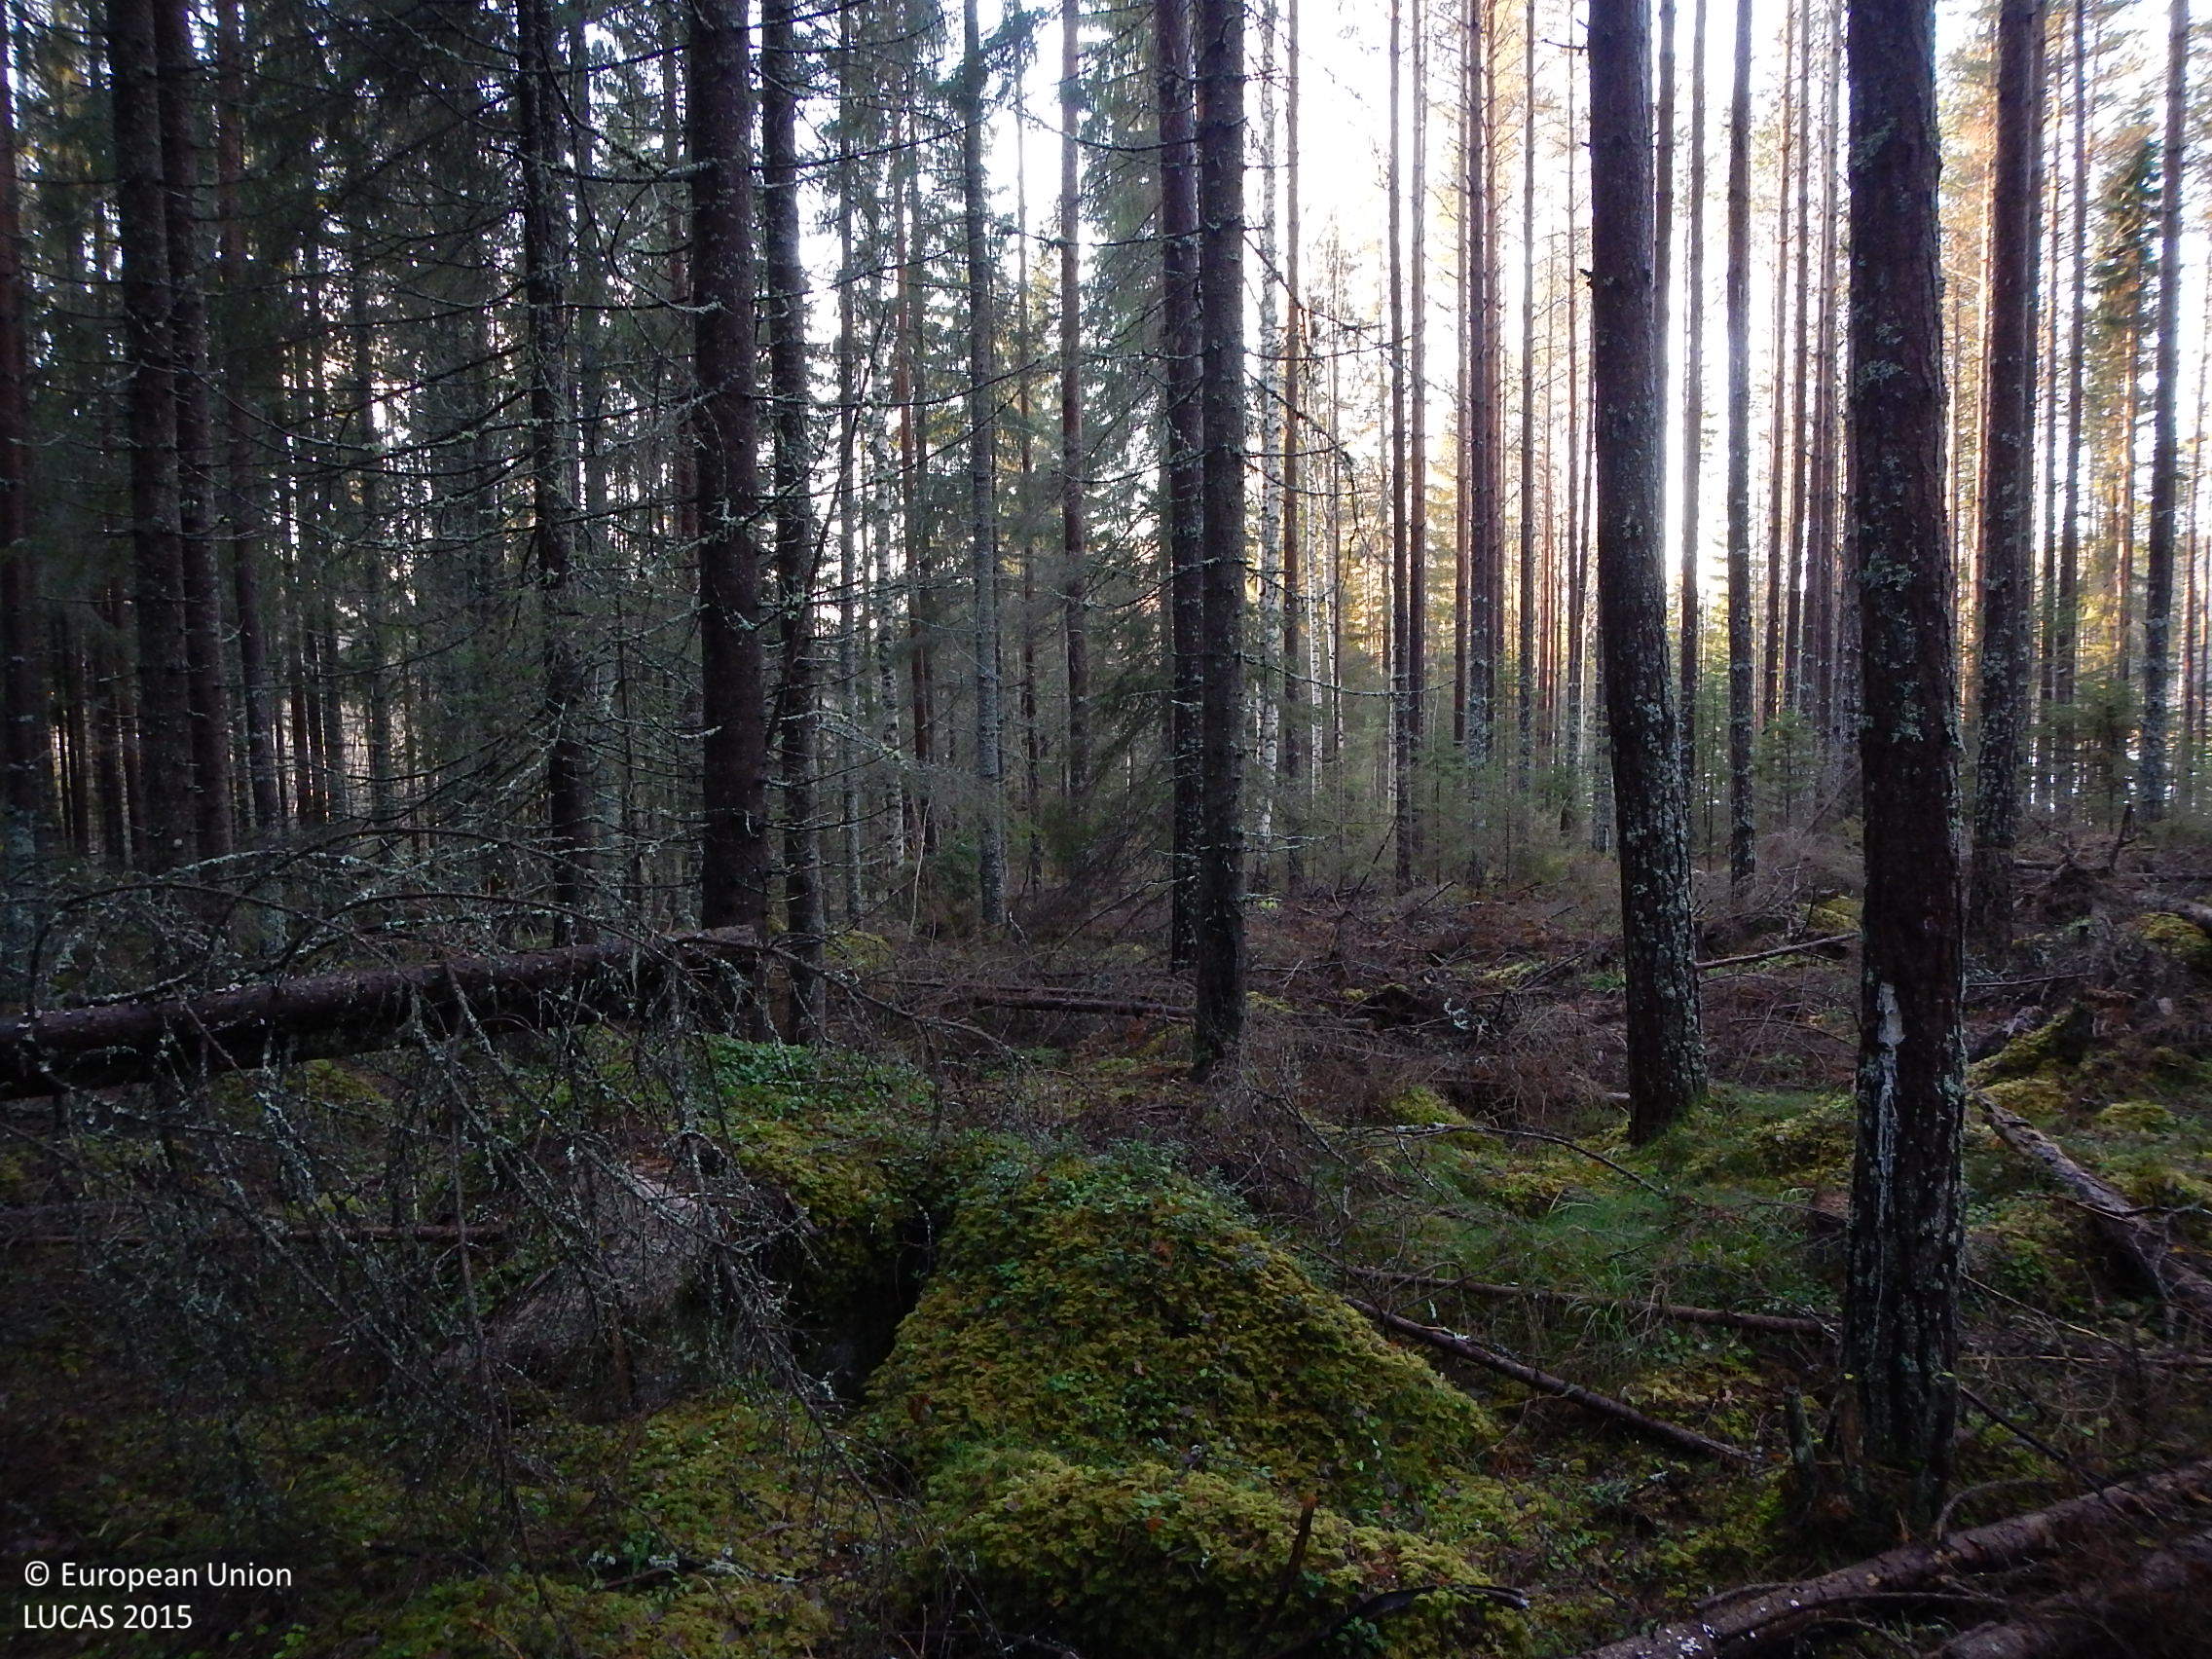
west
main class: Woodland
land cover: Spruce dominated coniferous woodland
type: boreal forest
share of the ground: > 75 %
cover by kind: coniferous forest trees 80 %, lichens and mosses 15 %, broadleaved forest trees 5 %
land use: Forestry
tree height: > 5 m
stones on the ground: < 10 %
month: November
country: SE
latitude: 61.8813
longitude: 16.3539
